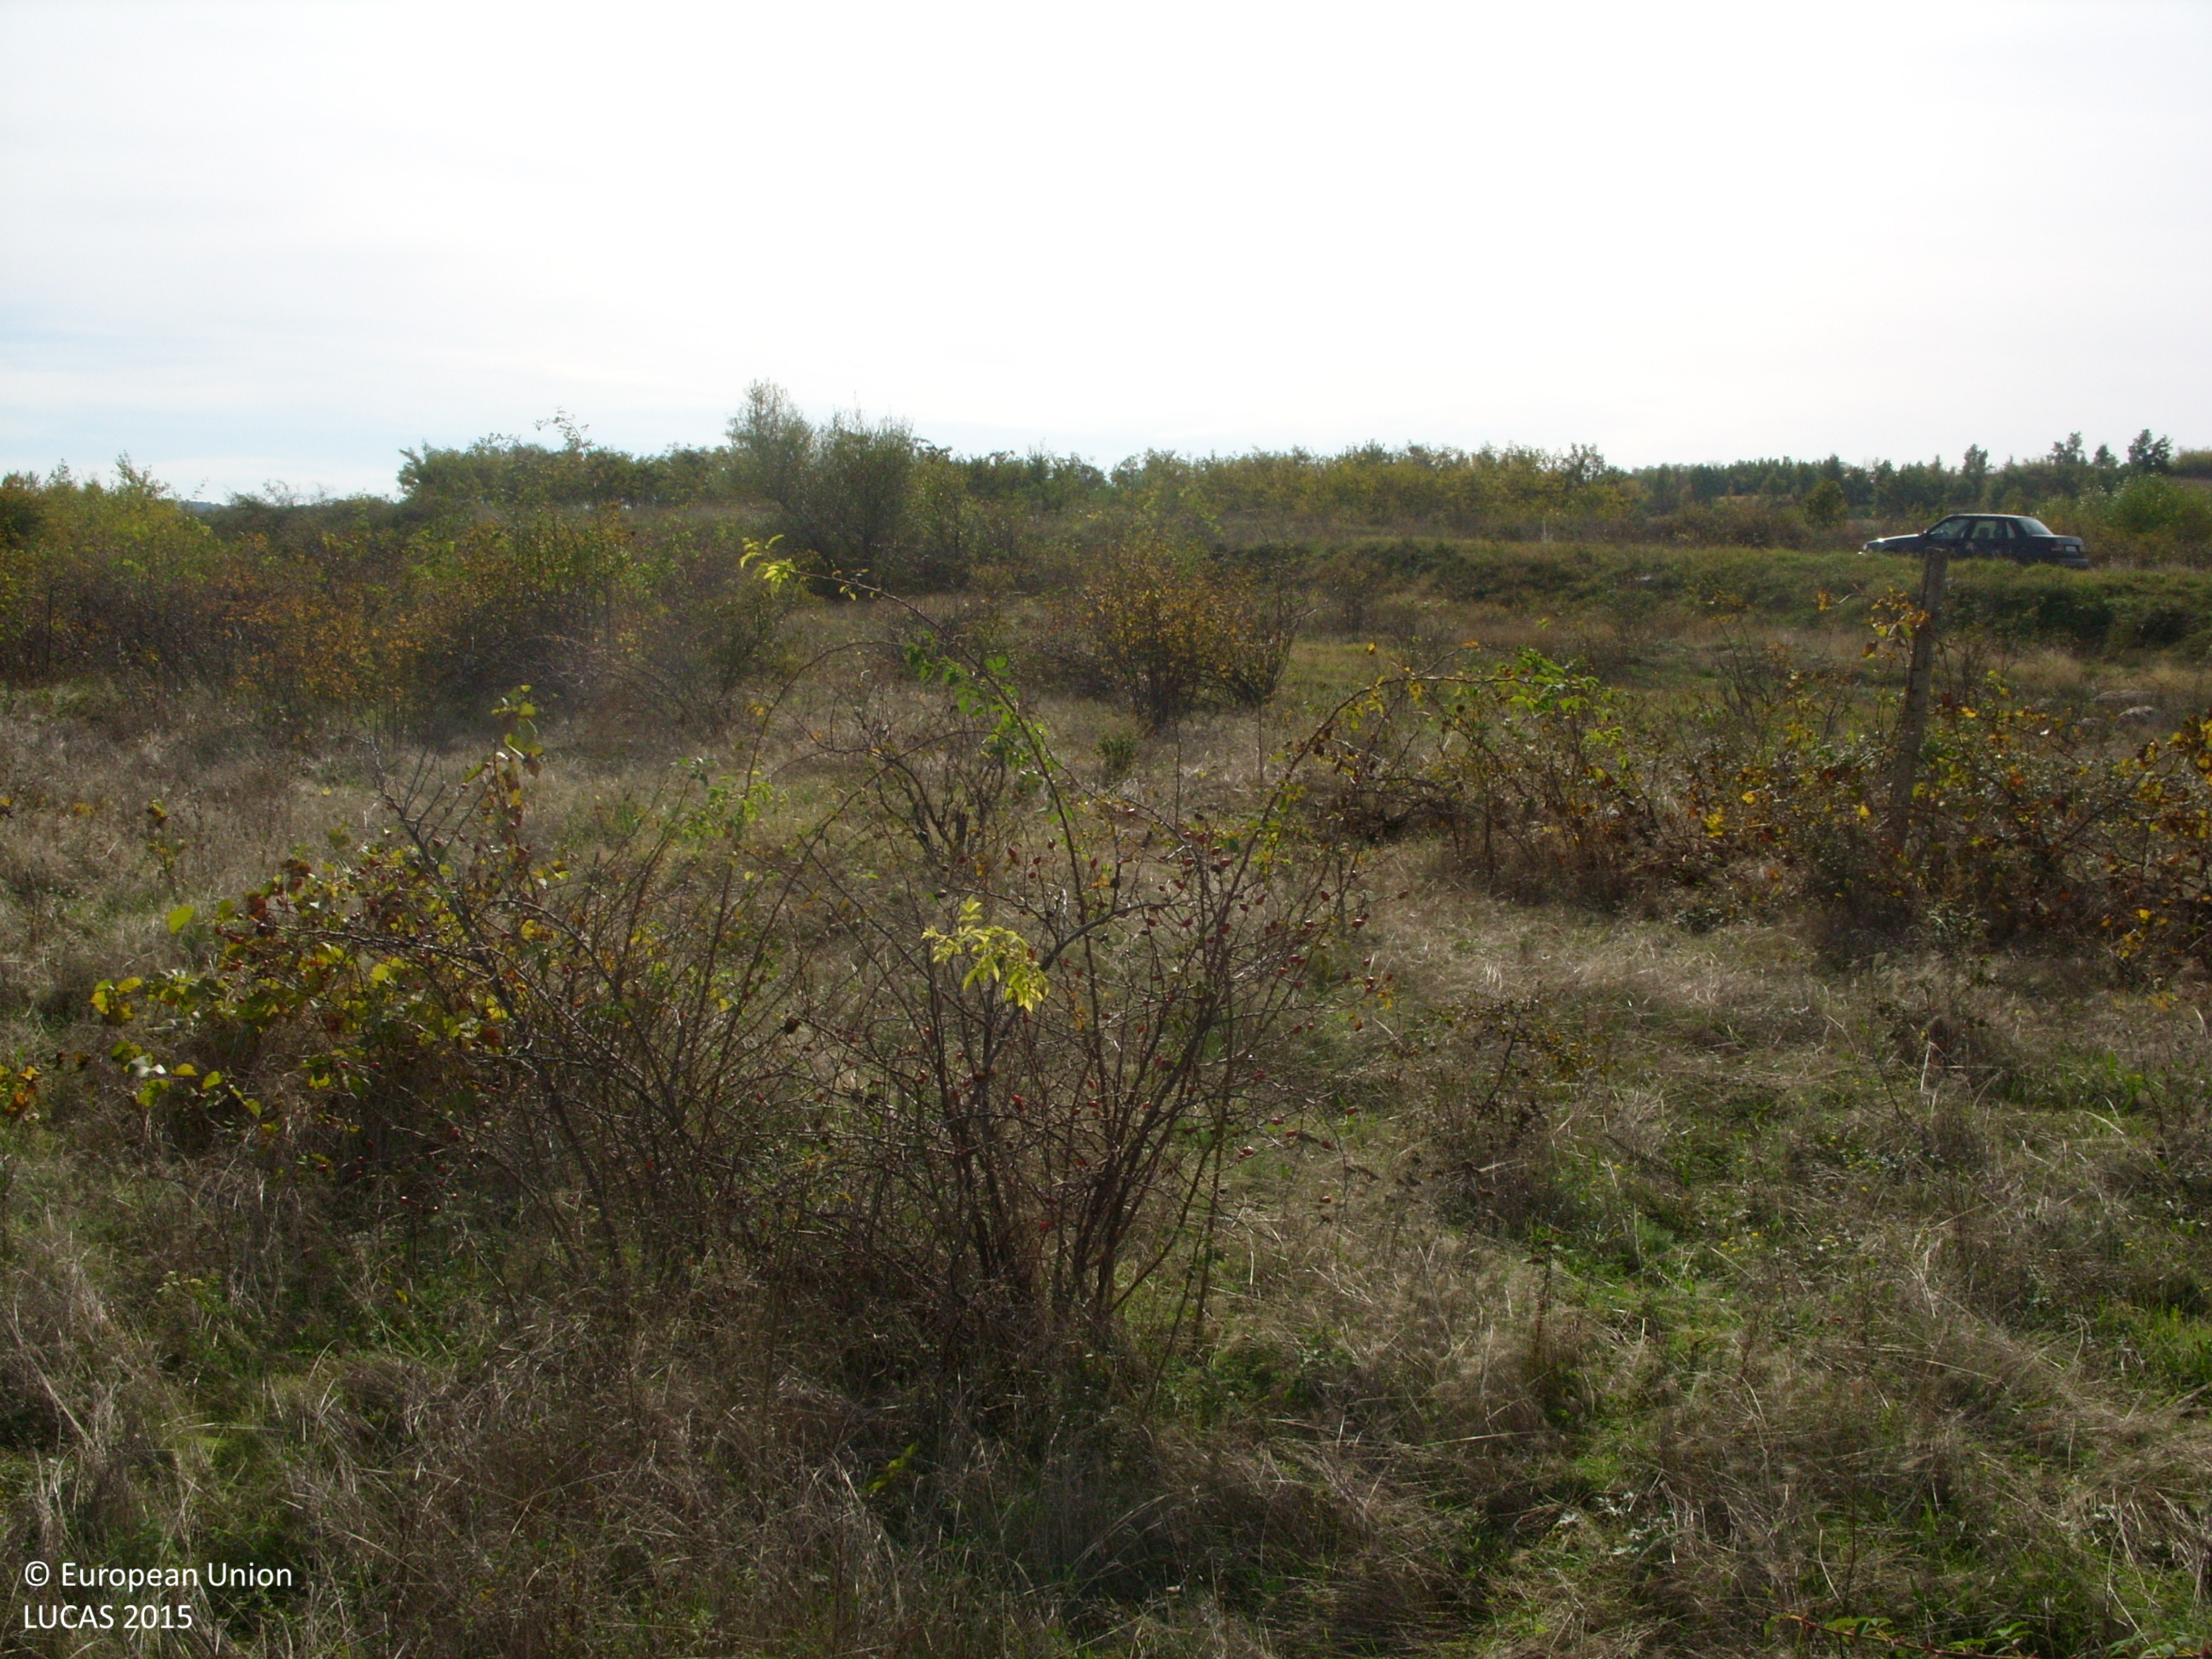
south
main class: Cropland
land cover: Vineyards
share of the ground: 50 - 75 %
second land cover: Spontaneously vegetated surfaces
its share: > 75 %
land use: Abandoned areas
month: October
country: BG
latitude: 42.2713
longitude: 24.1925
